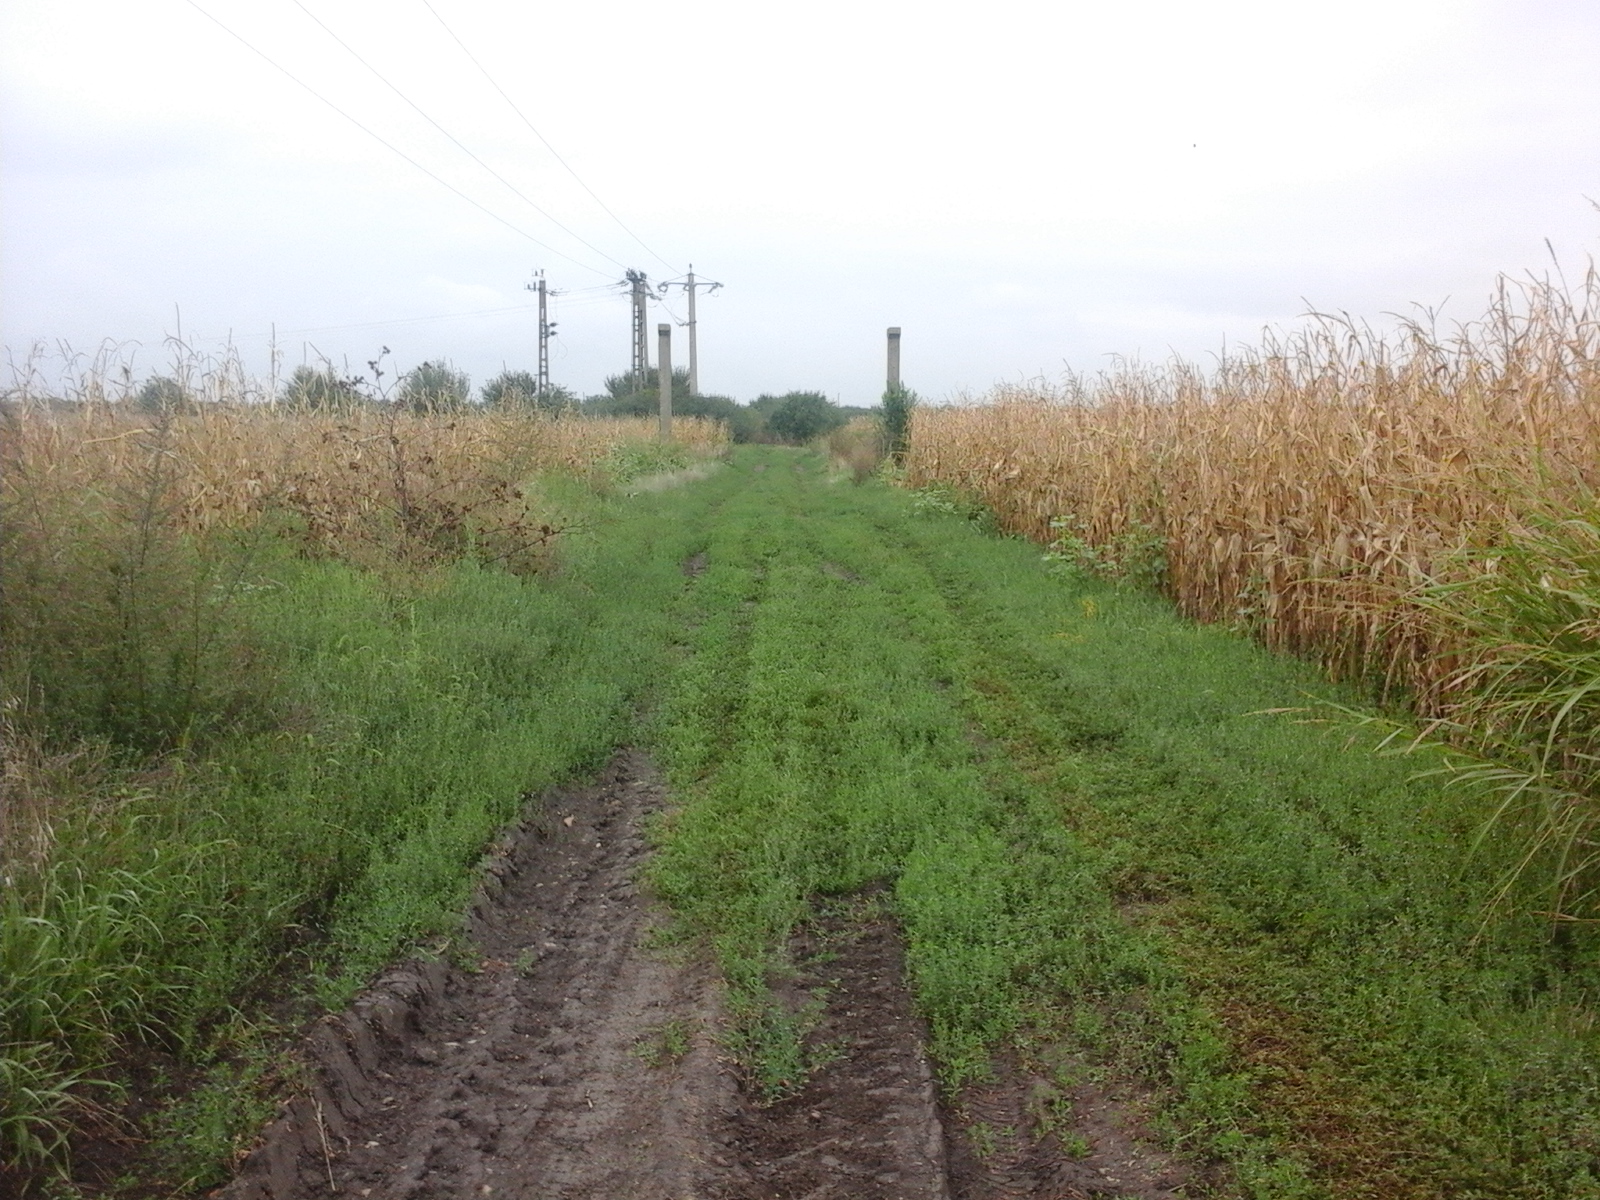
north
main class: Cropland
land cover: Maize
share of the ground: > 75 %
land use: Agriculture (excluding fallow land and kitchen gardens)
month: September
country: RO
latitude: 47.1101
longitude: 21.8399
